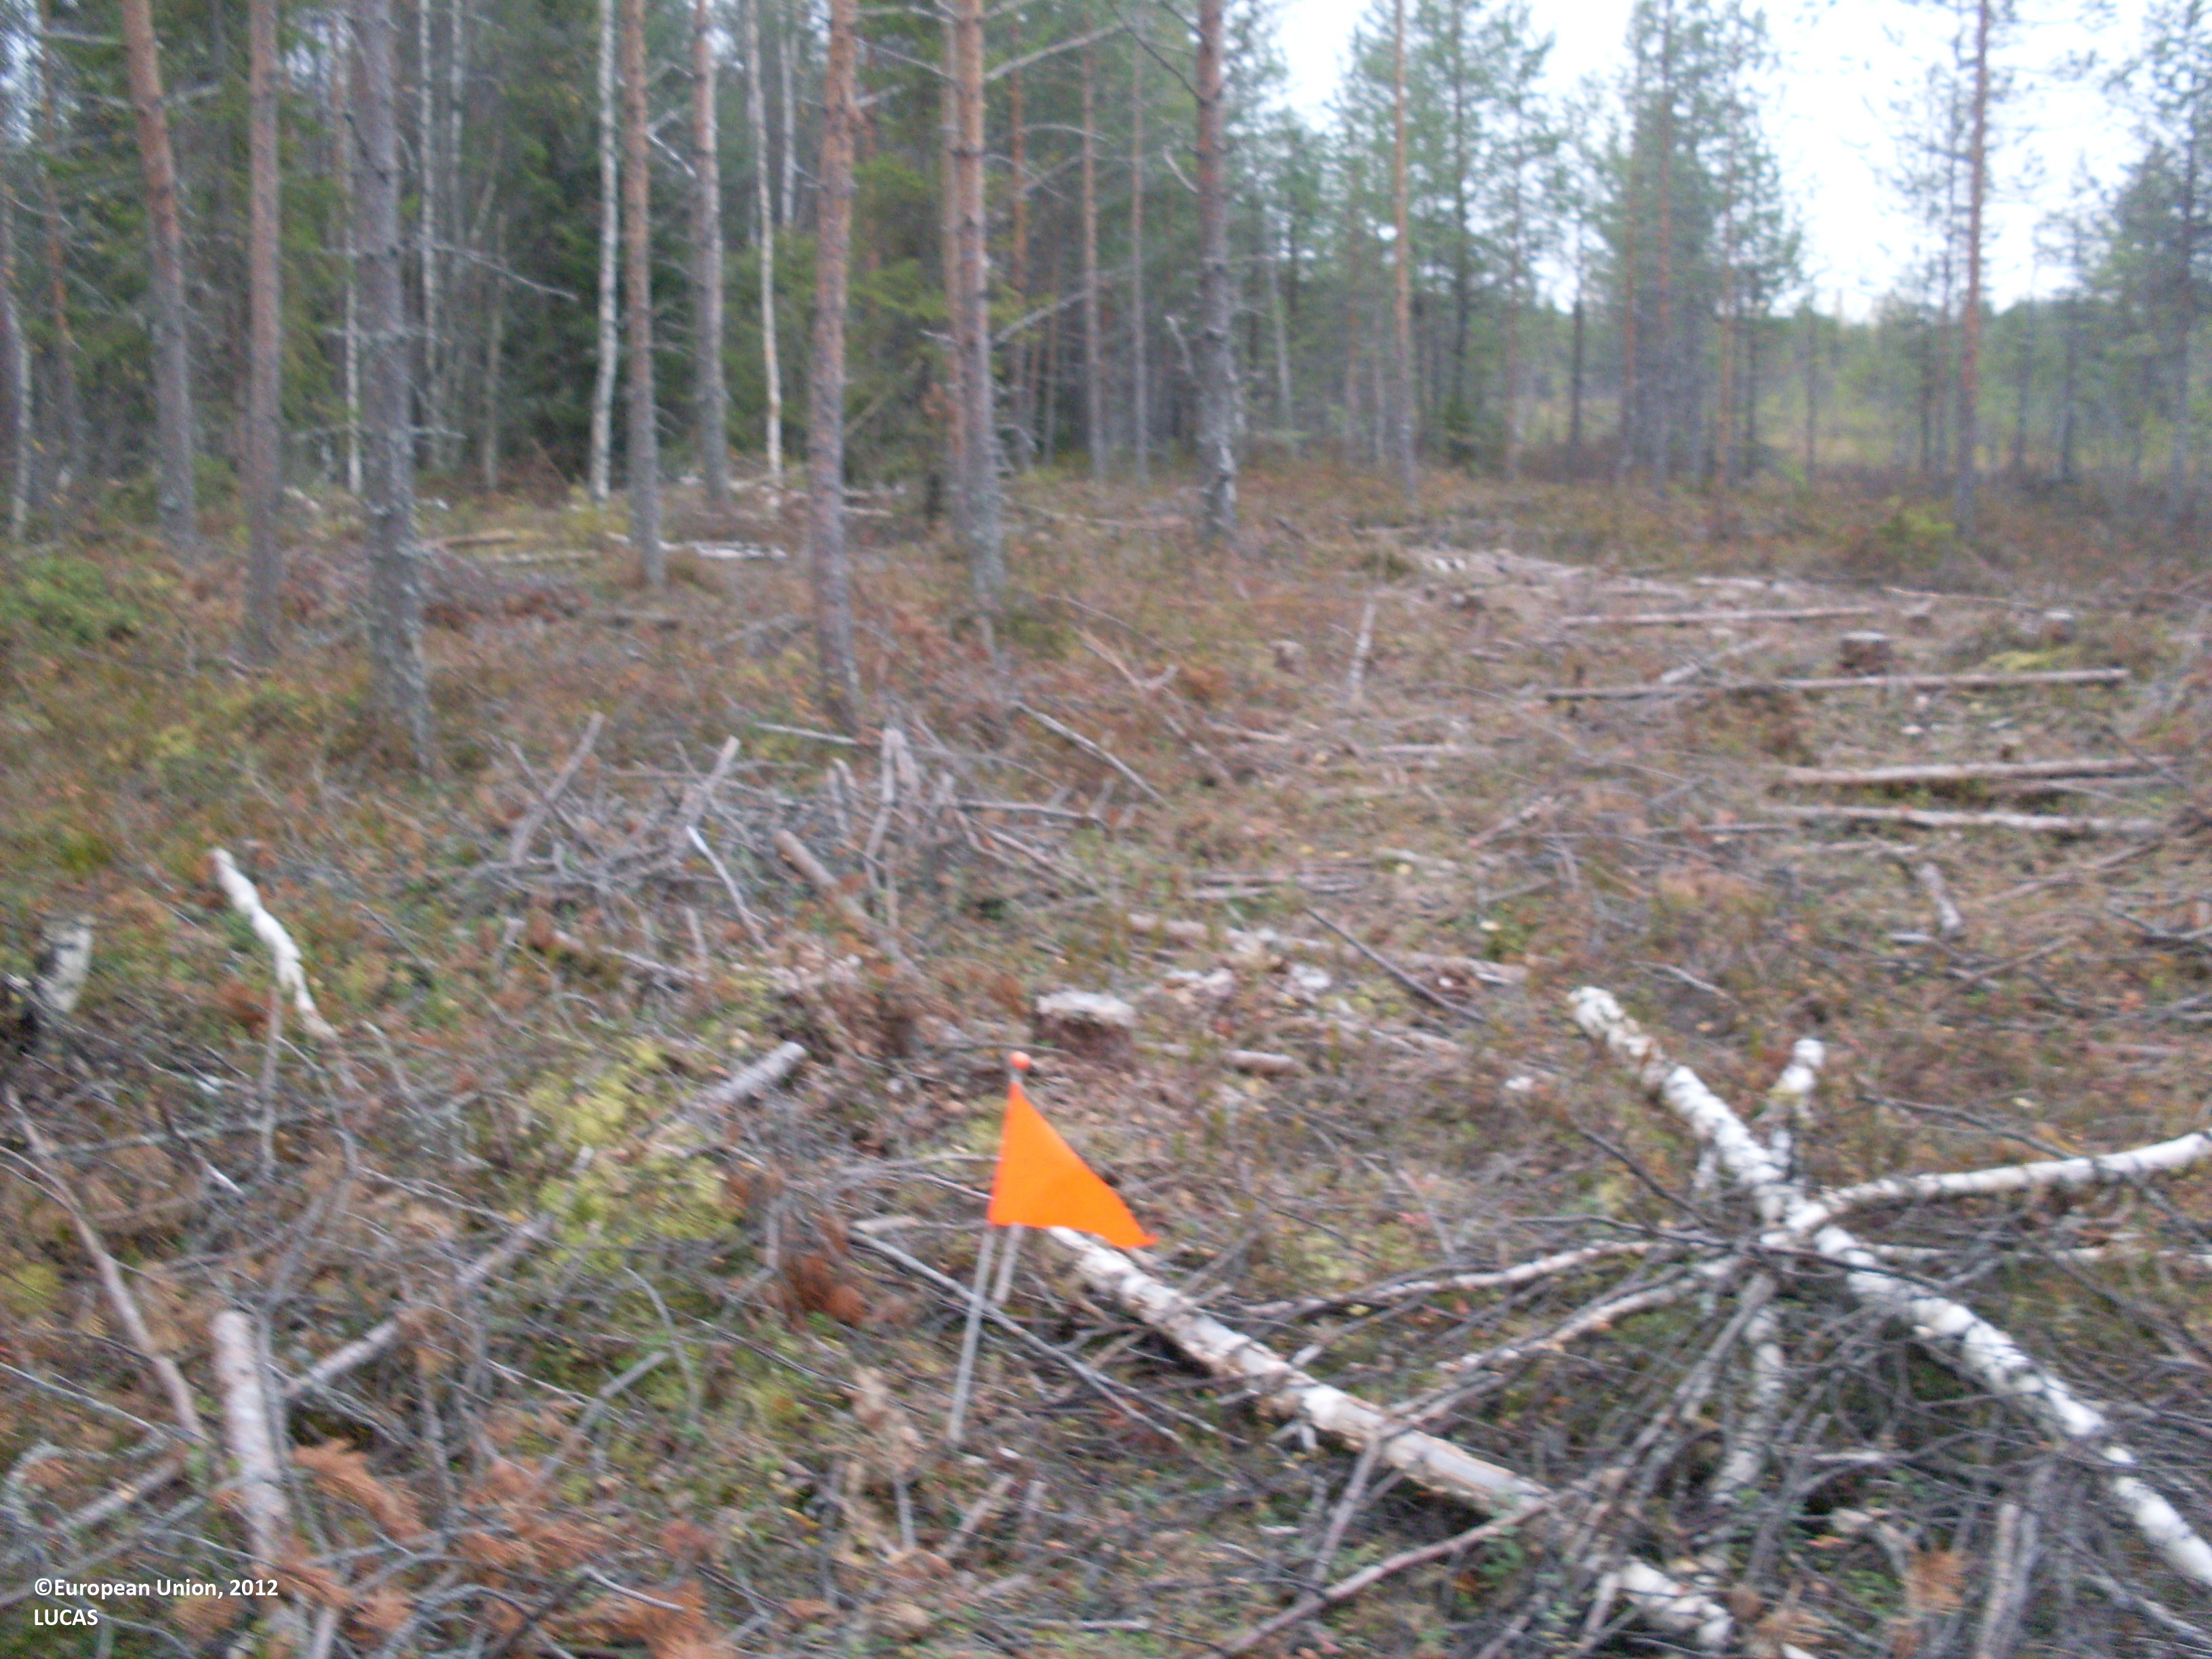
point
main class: Woodland
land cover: Pine dominated mixed woodland
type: boreal forest
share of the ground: 25 - 50 %
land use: Forestry
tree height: > 5 m
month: September
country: FI
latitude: 64.3116
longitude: 29.9386
